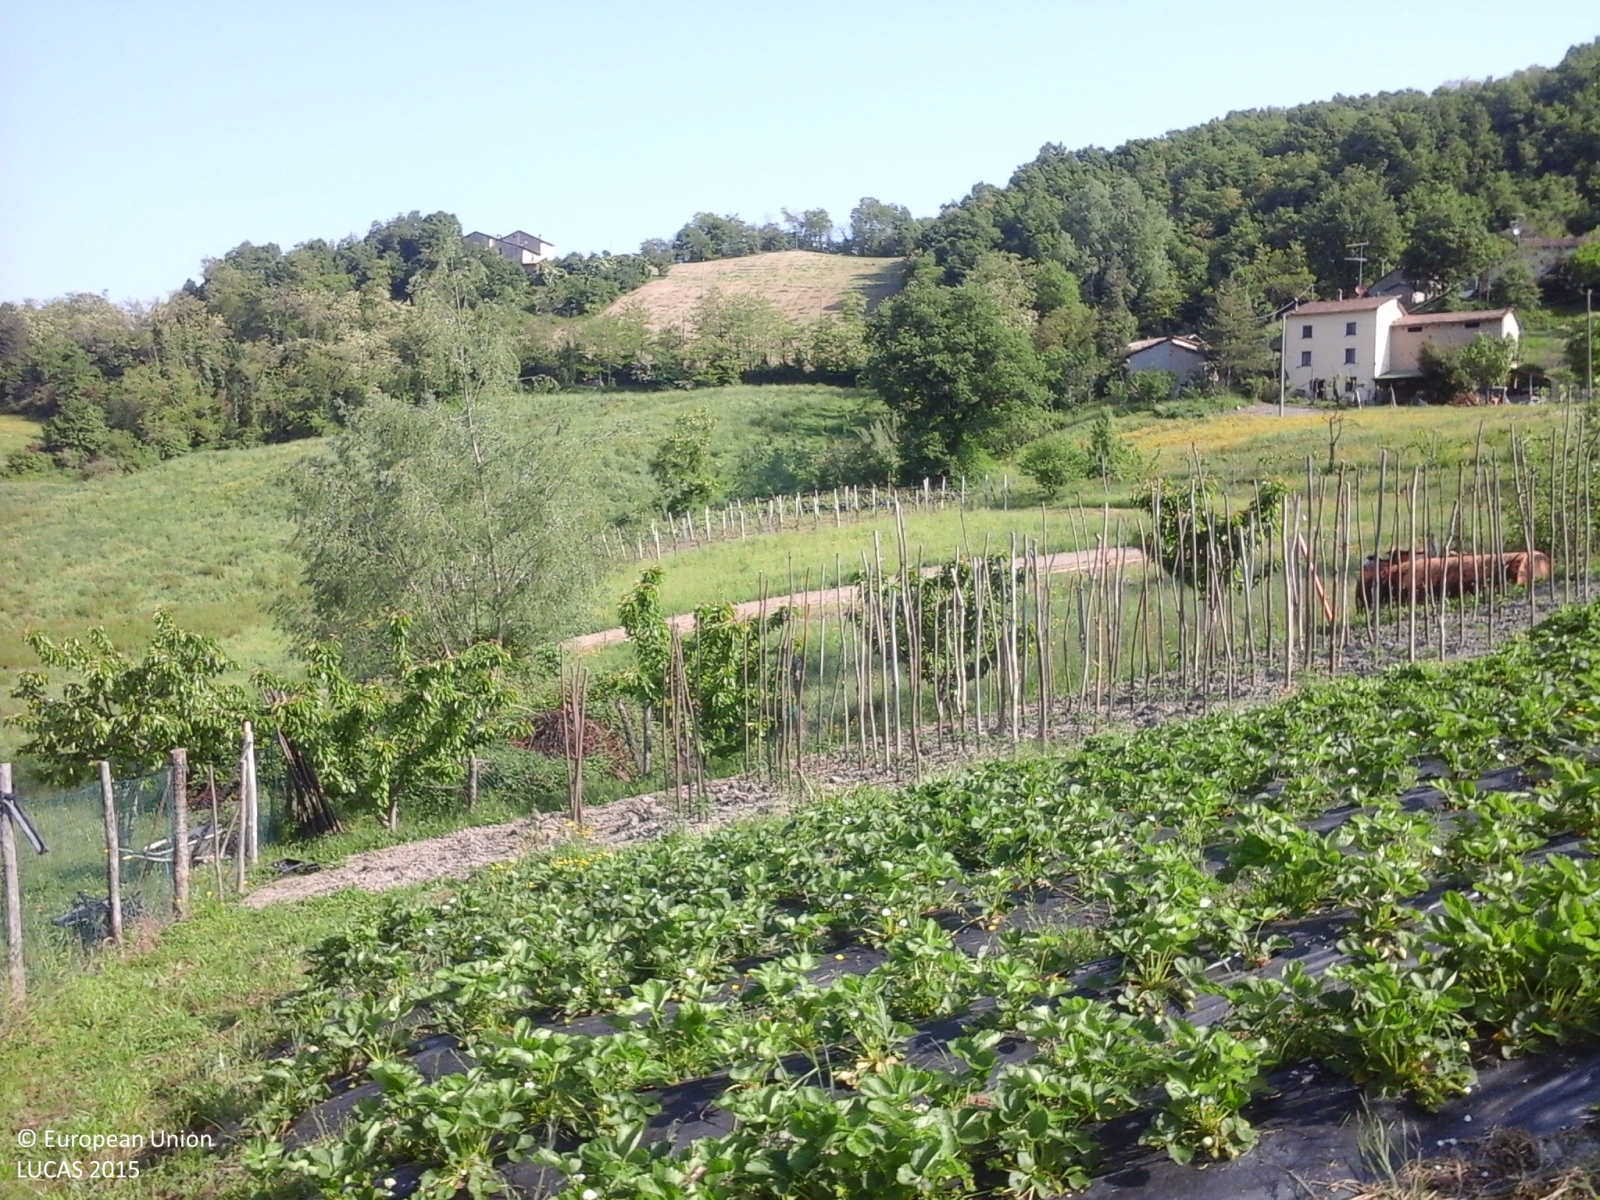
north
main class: Cropland
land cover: Potatoes
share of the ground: 10 - 25 %
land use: Kitchen garden
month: May
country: IT
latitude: 44.3643
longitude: 10.9389
